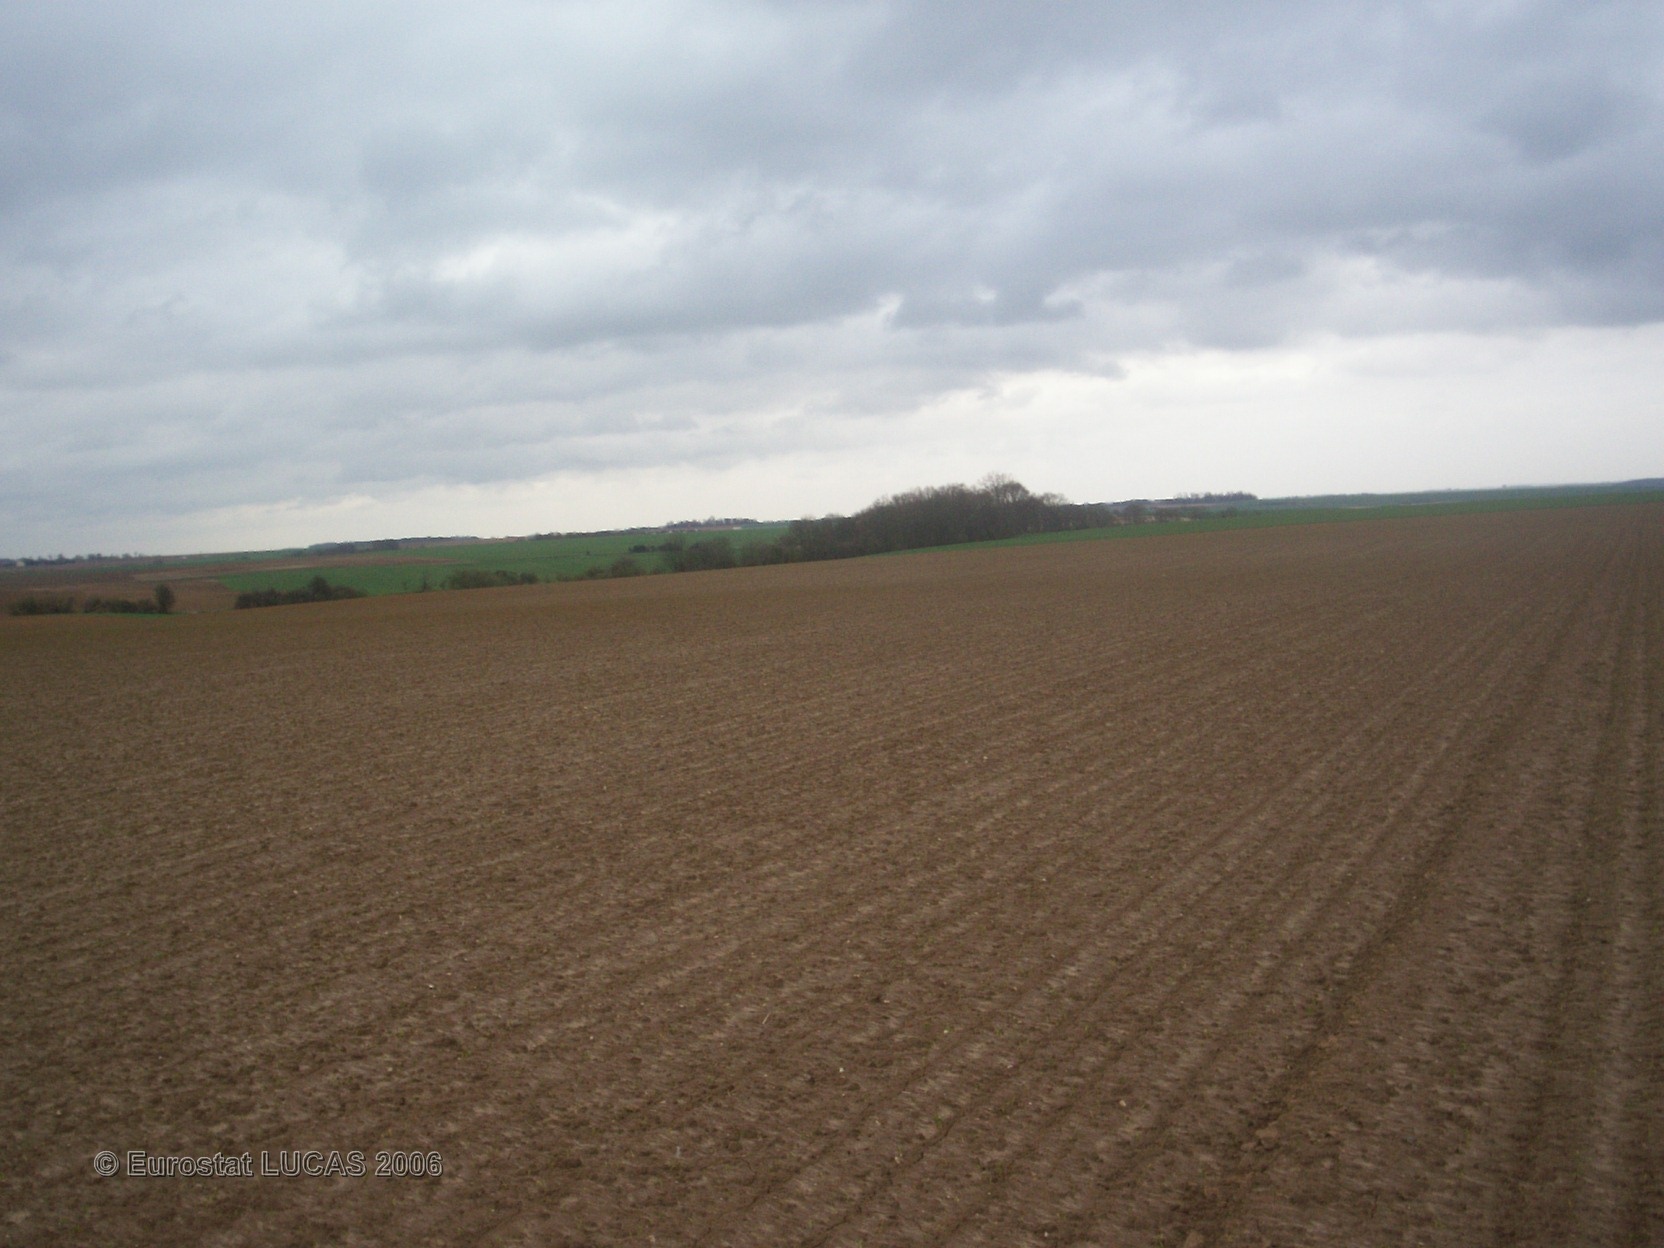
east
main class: Cropland
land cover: Maize
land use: Agriculture (excluding fallow land and kitchen gardens)
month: April
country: FR
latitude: 49.9680
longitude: 2.6971
